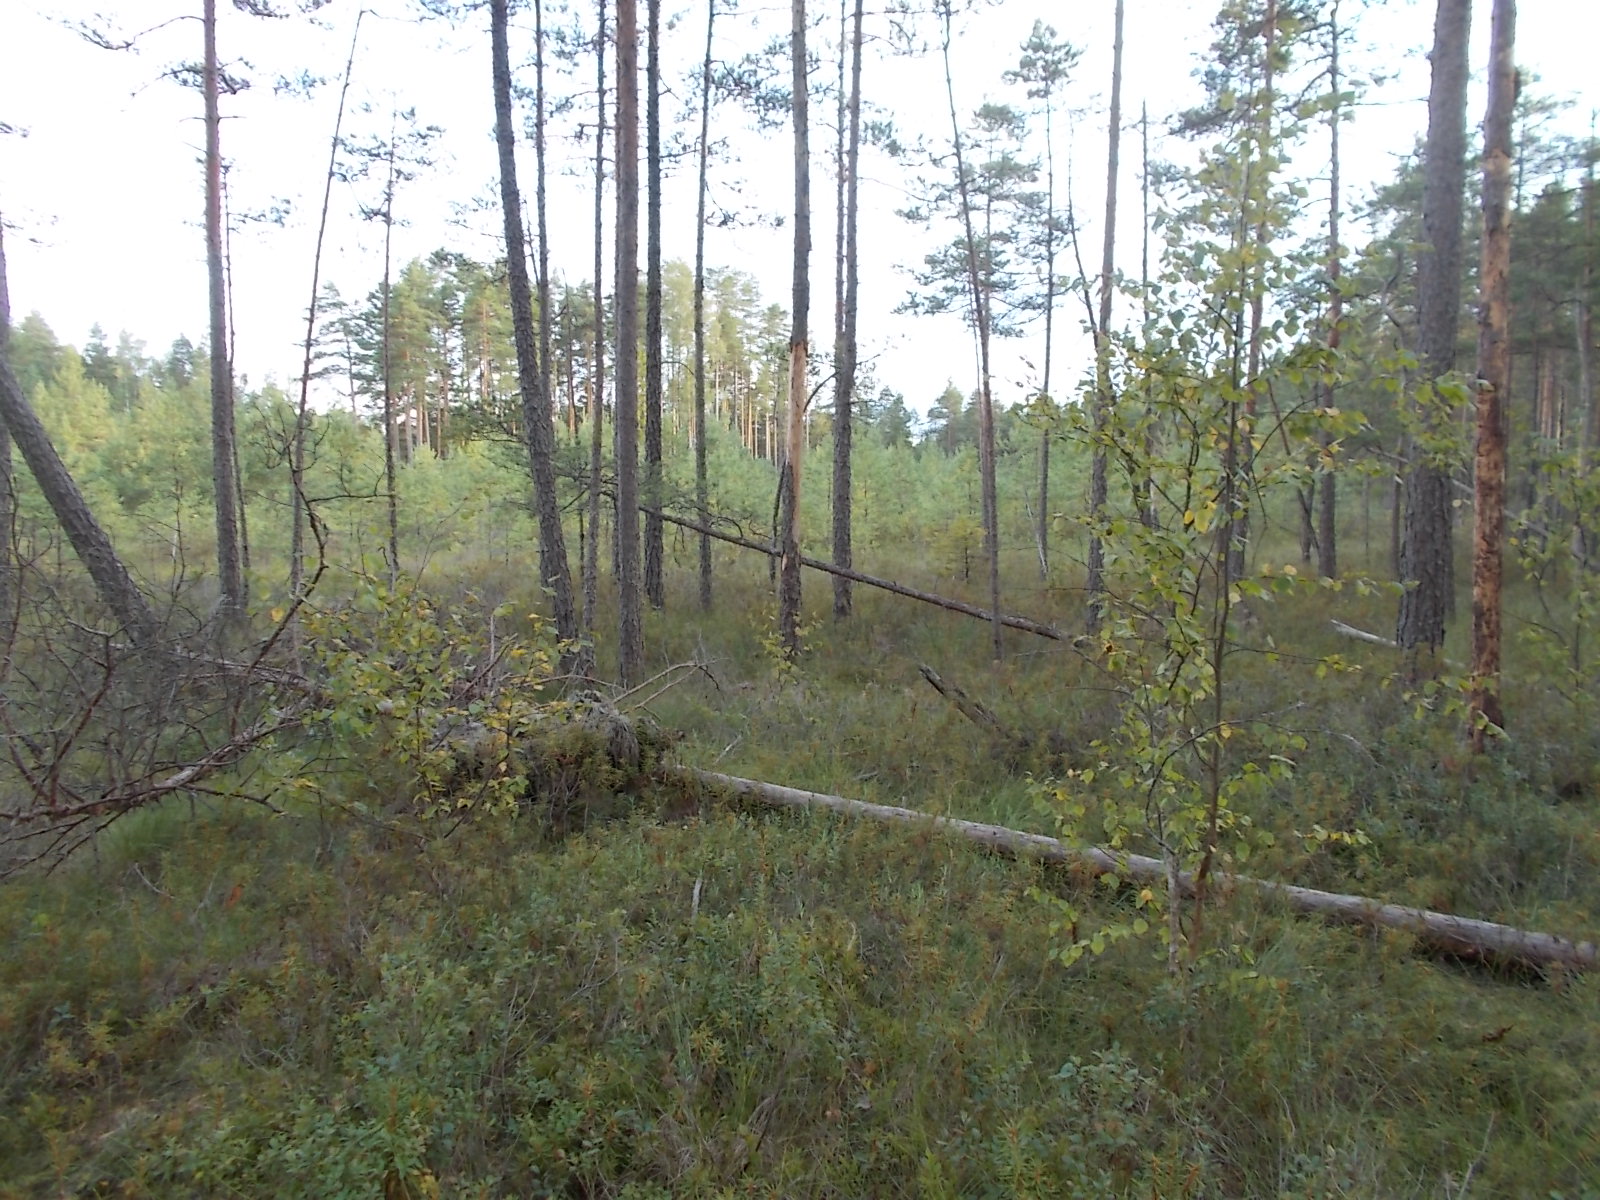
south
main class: Woodland
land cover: Pine dominated coniferous woodland
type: hemiboreal forest and nemoral coniferous forest and mixed broadleaved-coniferous forest
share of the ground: 25 - 50 %
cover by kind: coniferous forest trees 40 %, herbaceous plants 30 %, broadleaved forest trees 10 %, shrubs 10 %, lichens and mosses 10 %
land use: Forestry
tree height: > 5 m
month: September
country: LV
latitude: 57.1752
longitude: 21.9383
